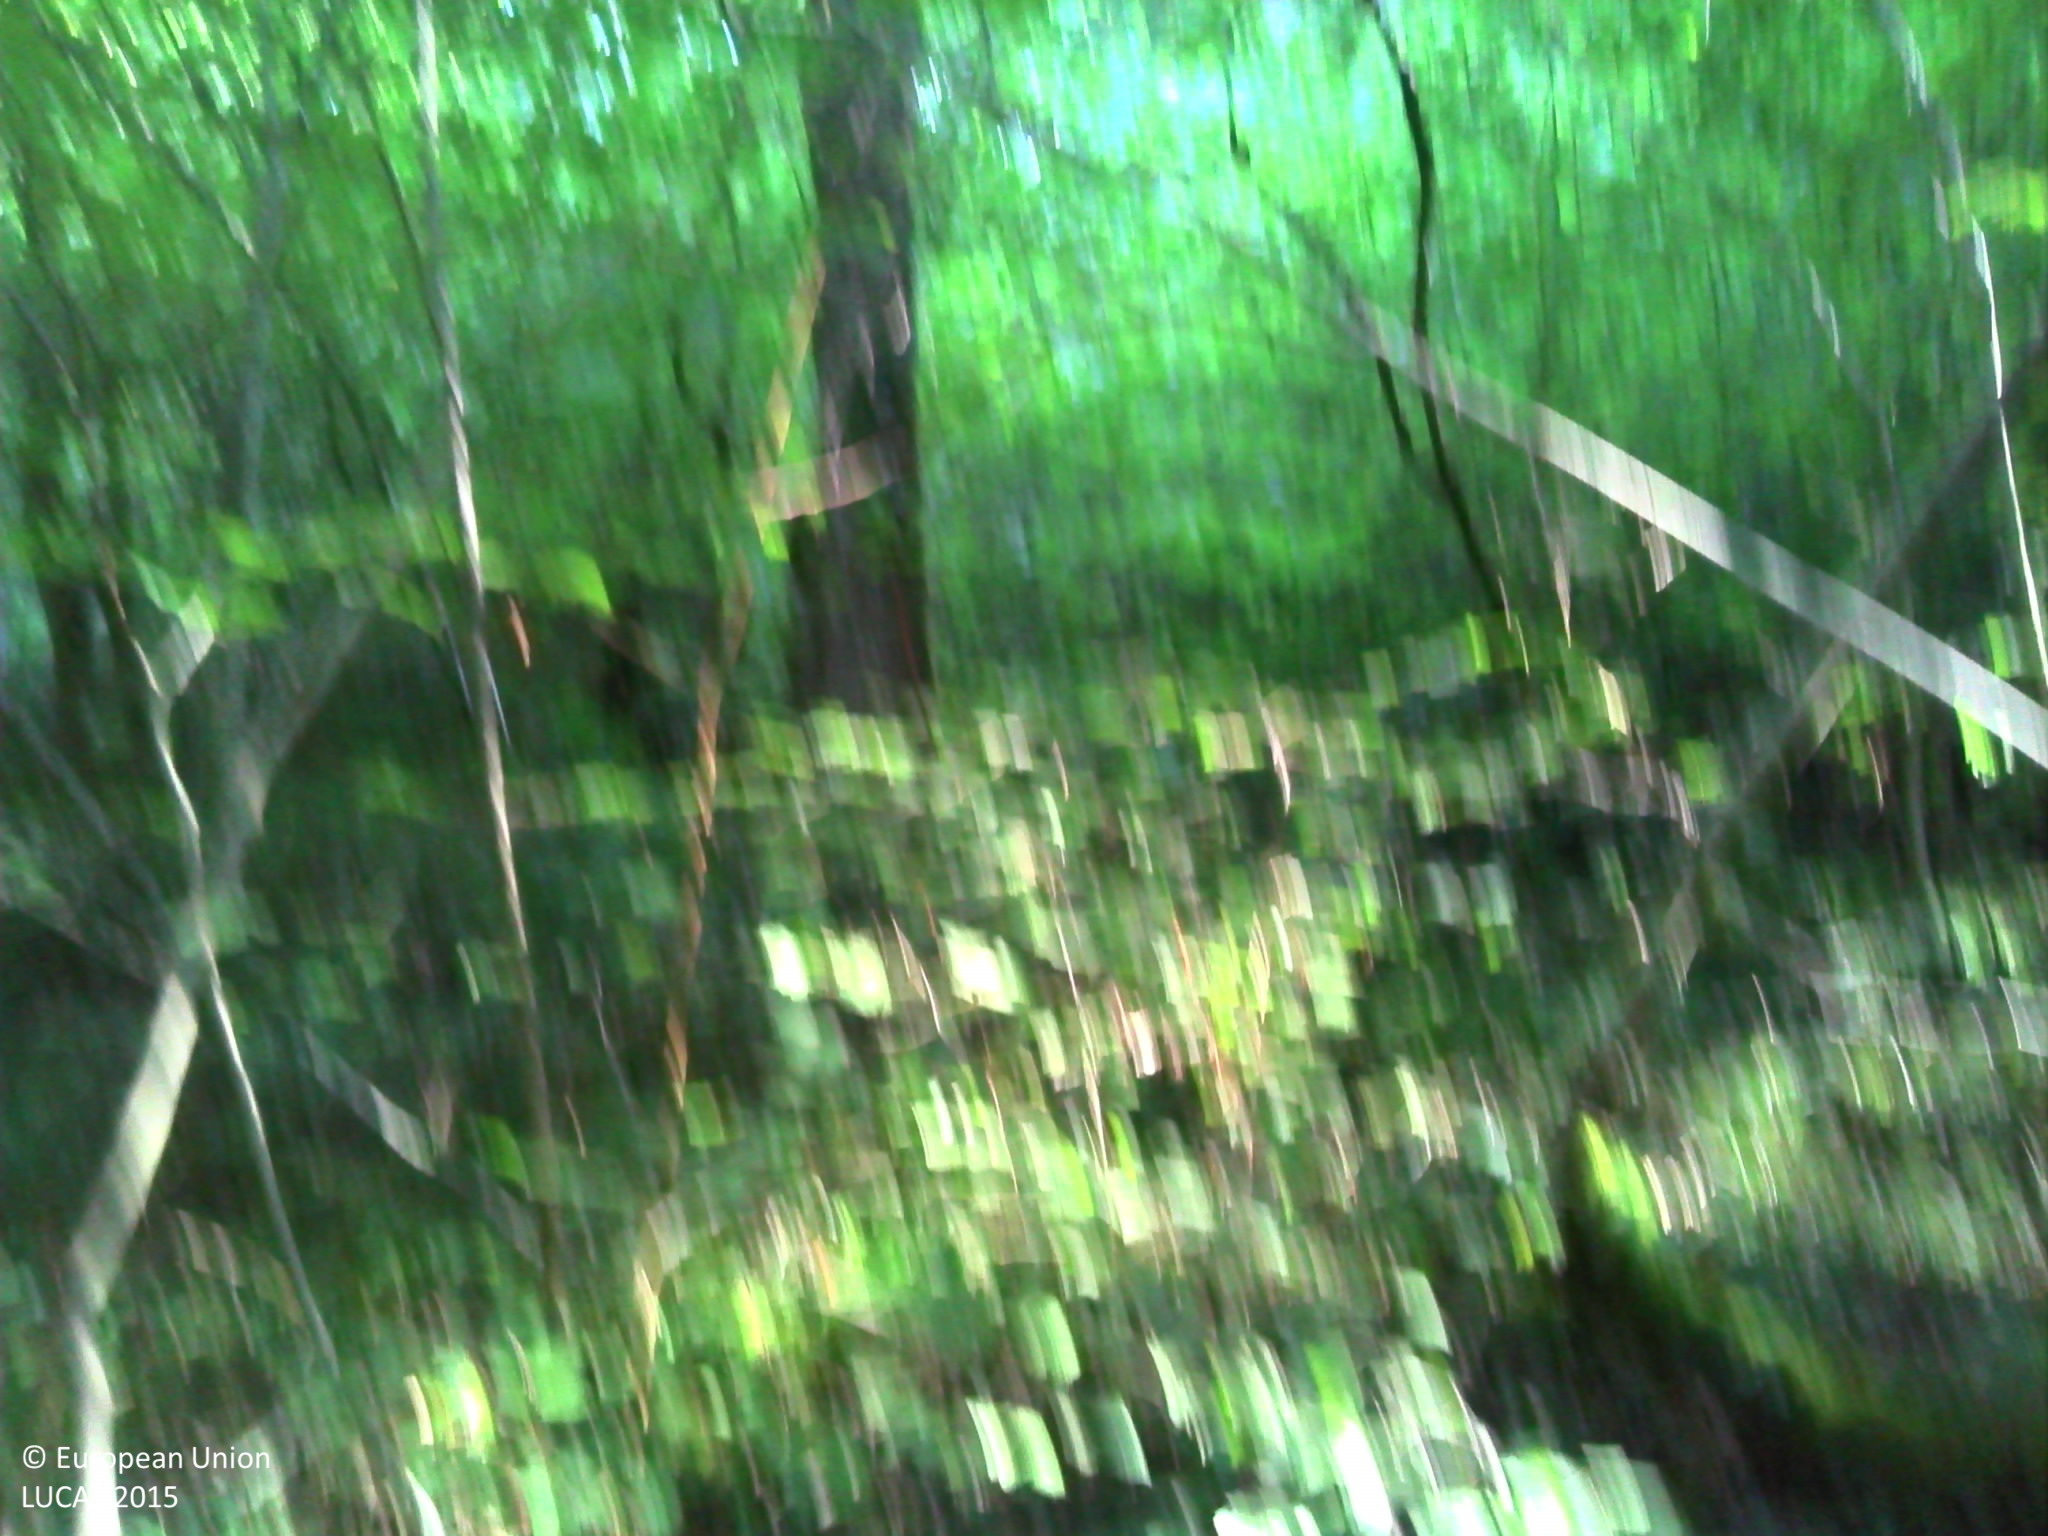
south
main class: Woodland
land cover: Broadleaved woodland
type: mesophytic deciduous forest
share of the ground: > 75 %
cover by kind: broadleaved forest trees 100 %
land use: Forestry
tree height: > 5 m
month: August
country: FR
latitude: 47.1793
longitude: 2.0868
